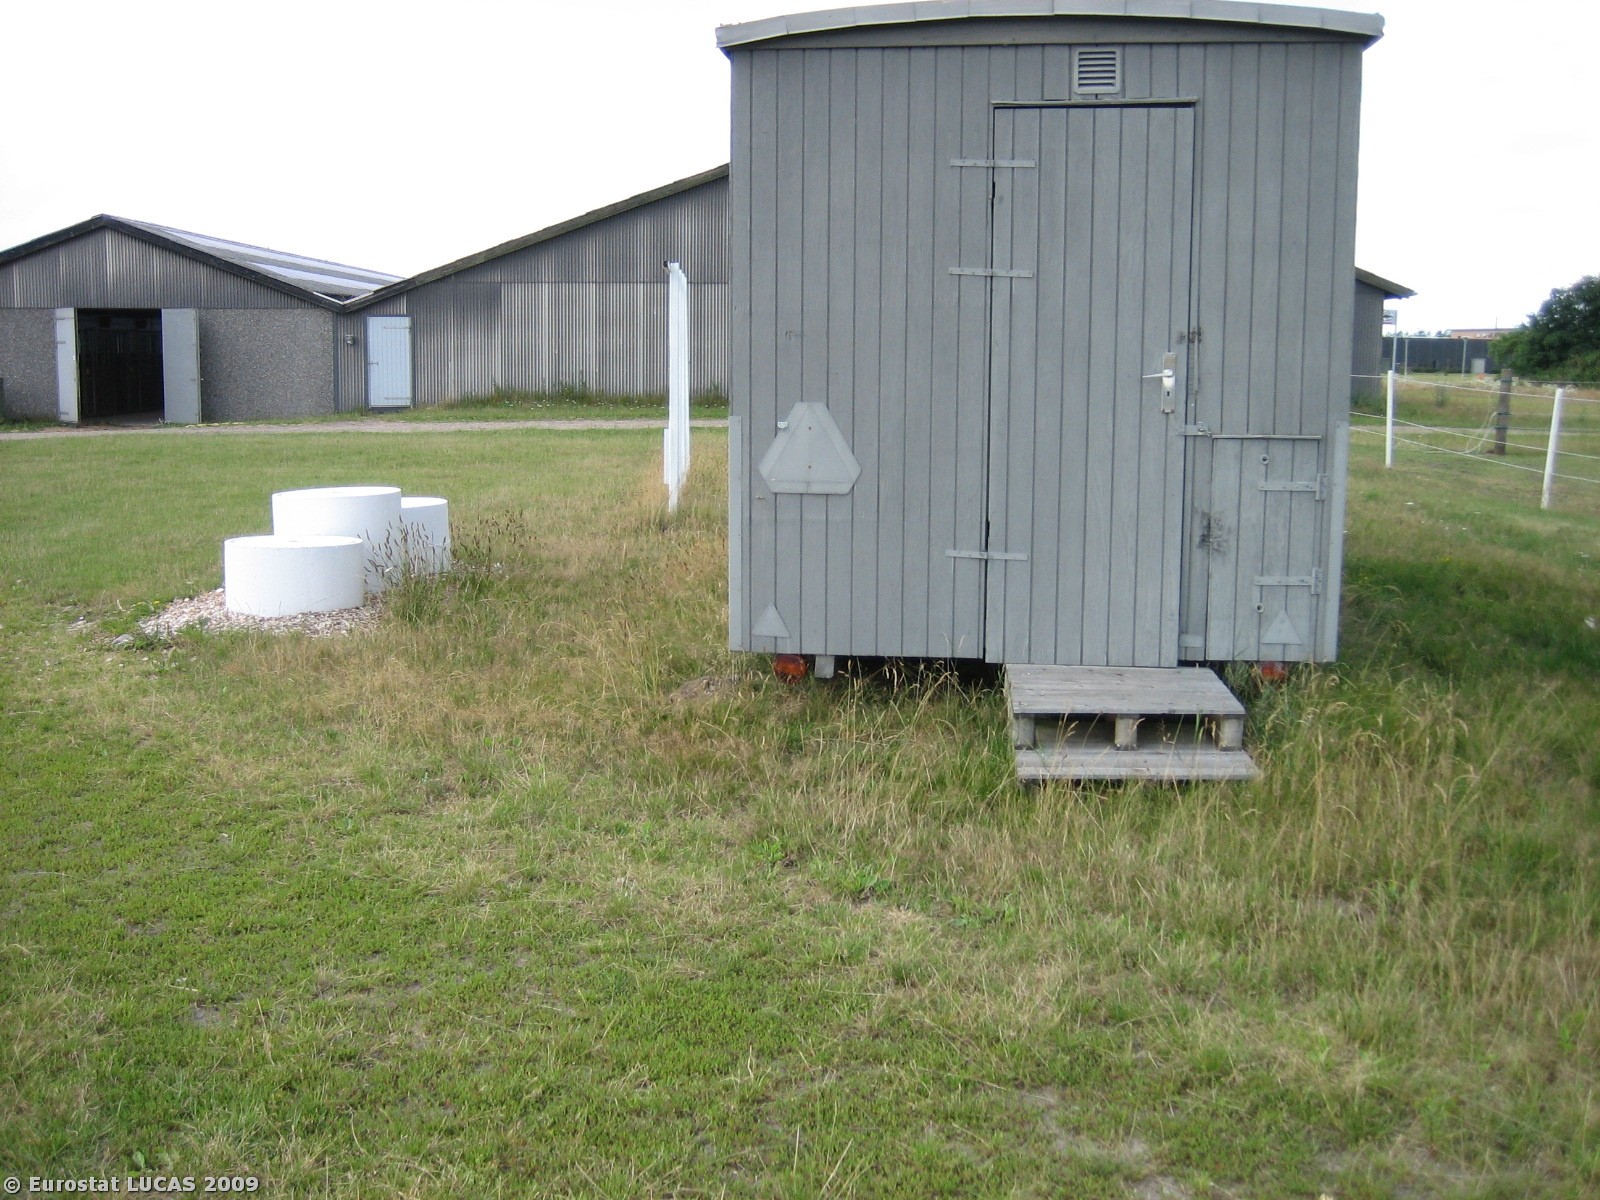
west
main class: Grassland
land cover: Grassland without tree/shrub cover
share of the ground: > 75 %
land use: Amenities, museums, leisure
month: July
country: DK
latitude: 55.7521
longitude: 8.9654
